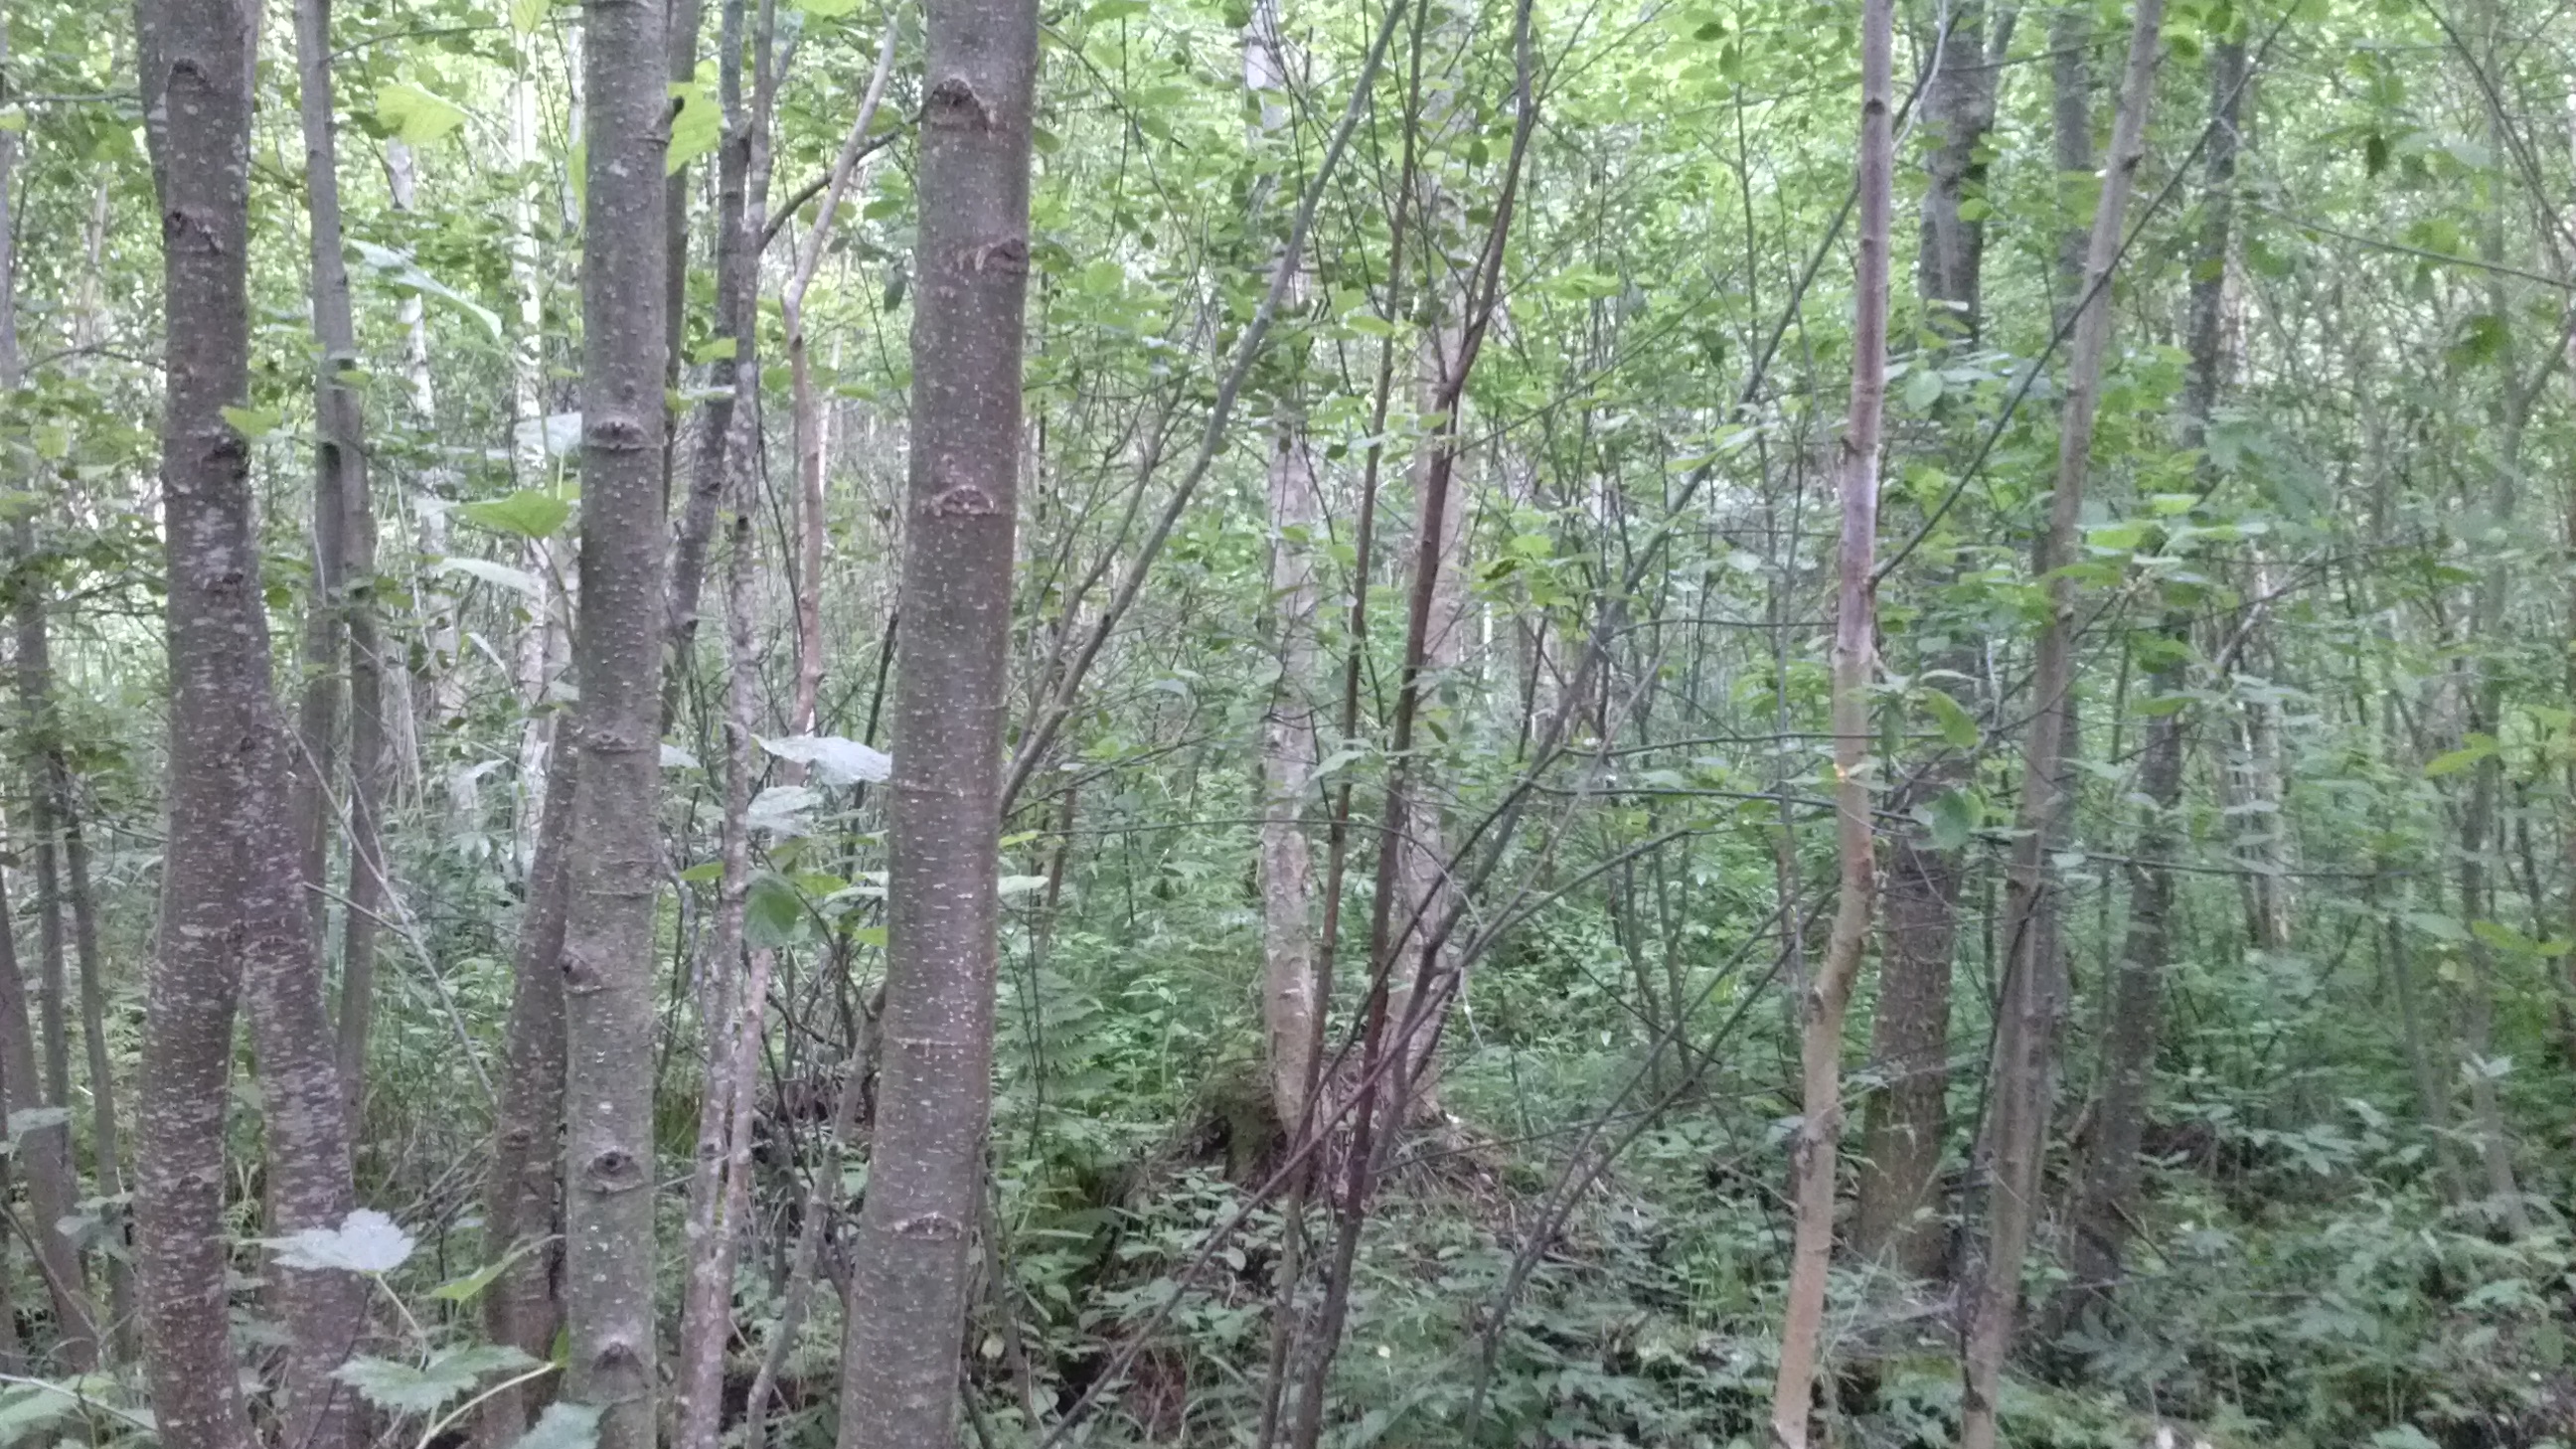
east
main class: Woodland
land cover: Broadleaved woodland
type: non-riverine alder, birch or aspen forest
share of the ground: > 75 %
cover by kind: broadleaved forest trees 80 %, herbaceous plants 15 %, shrubs 5 %
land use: Forestry
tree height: > 5 m
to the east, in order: Broadleaved woodland
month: June
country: LV
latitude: 56.6082
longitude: 27.9354
